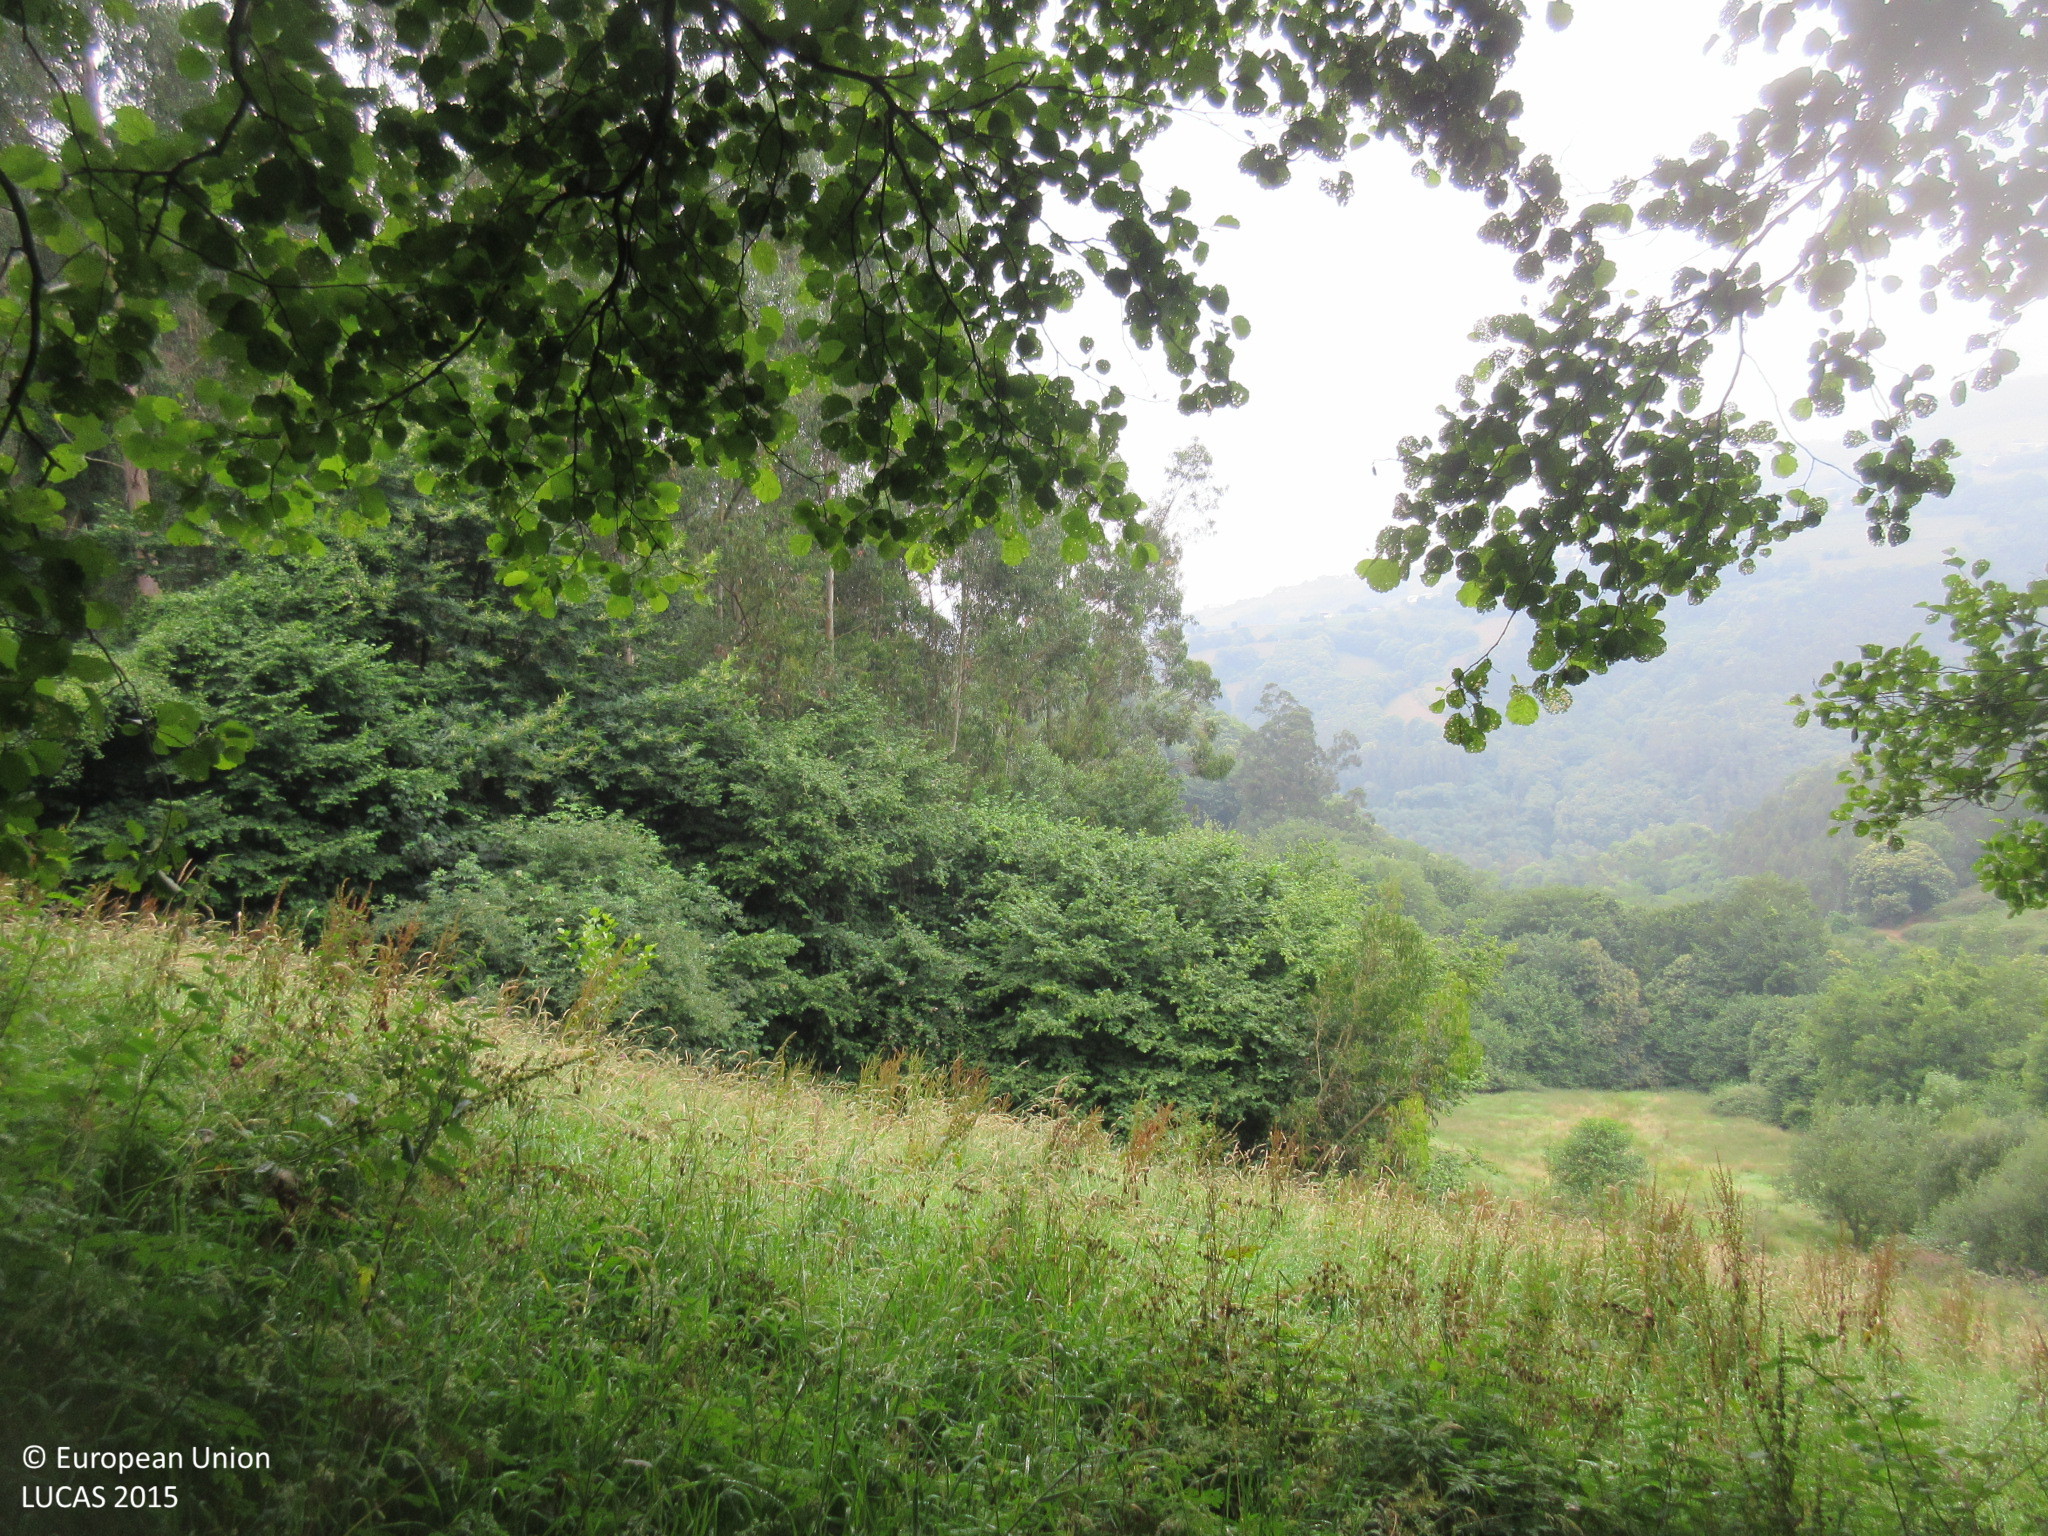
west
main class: Grassland
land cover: Grassland without tree/shrub cover
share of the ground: > 75 %
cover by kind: herbaceous plants 100 %
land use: Agriculture (excluding fallow land and kitchen gardens)
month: July
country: ES
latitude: 43.4338
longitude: -6.3203
